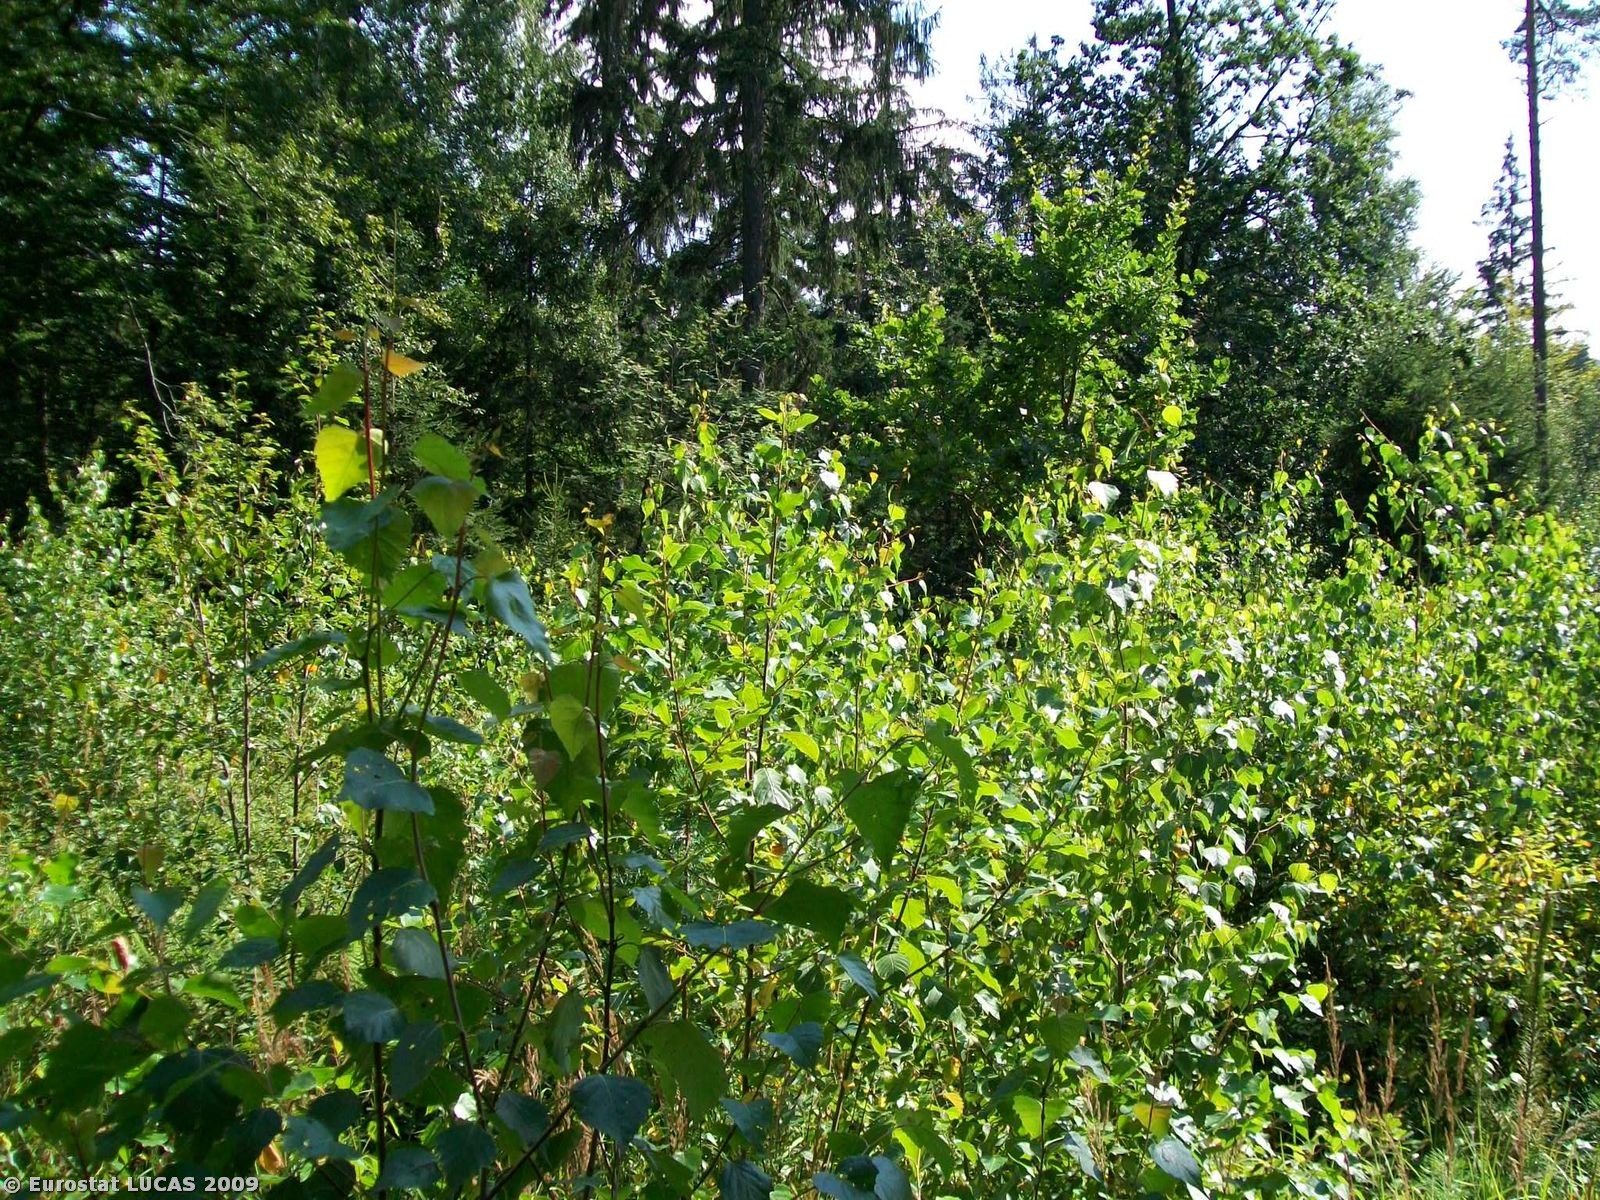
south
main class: Woodland
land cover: Mixed woodland
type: hemiboreal forest and nemoral coniferous forest and mixed broadleaved-coniferous forest
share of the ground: > 75 %
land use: Nature reserves
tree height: > 5 m
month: August
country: PL
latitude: 50.8516
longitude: 16.7275
